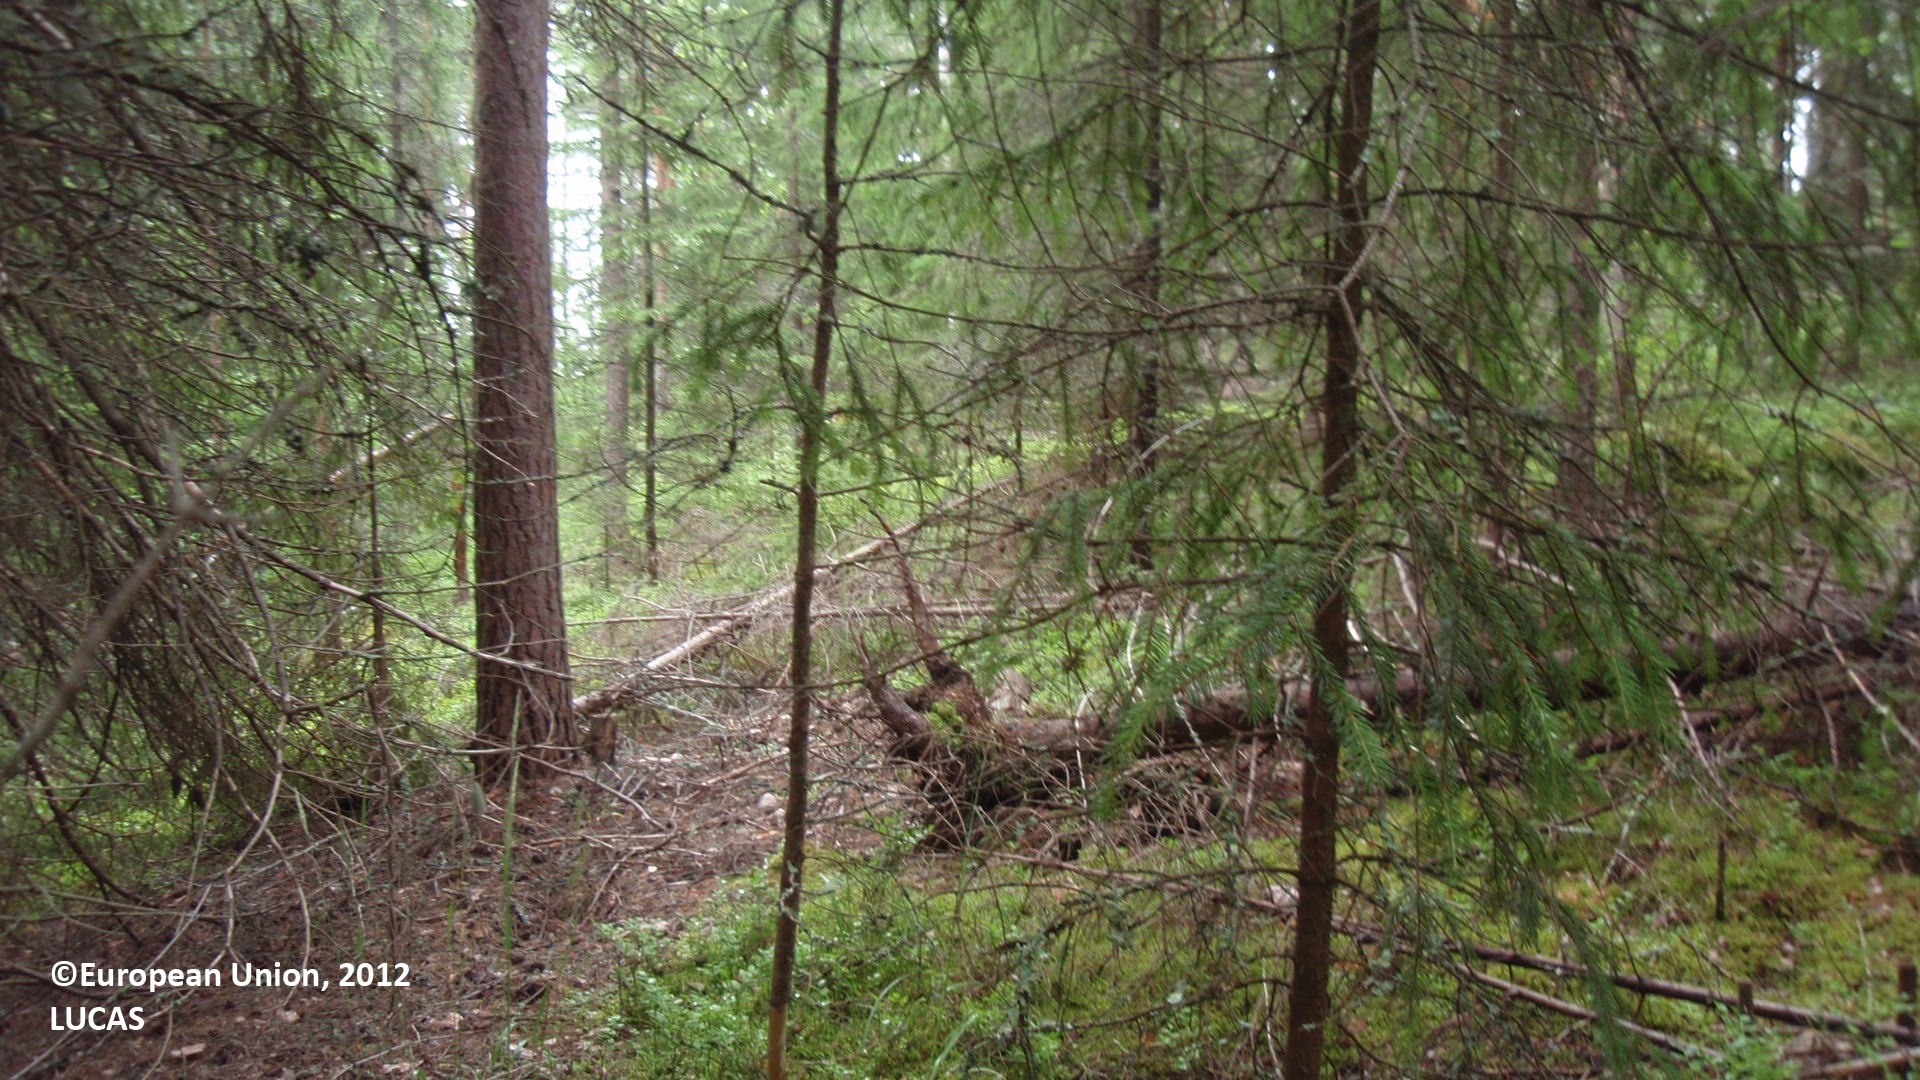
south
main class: Woodland
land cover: Spruce dominated coniferous woodland
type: boreal forest
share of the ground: 50 - 75 %
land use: Forestry
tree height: > 5 m
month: July
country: FI
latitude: 61.1222
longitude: 28.5764
